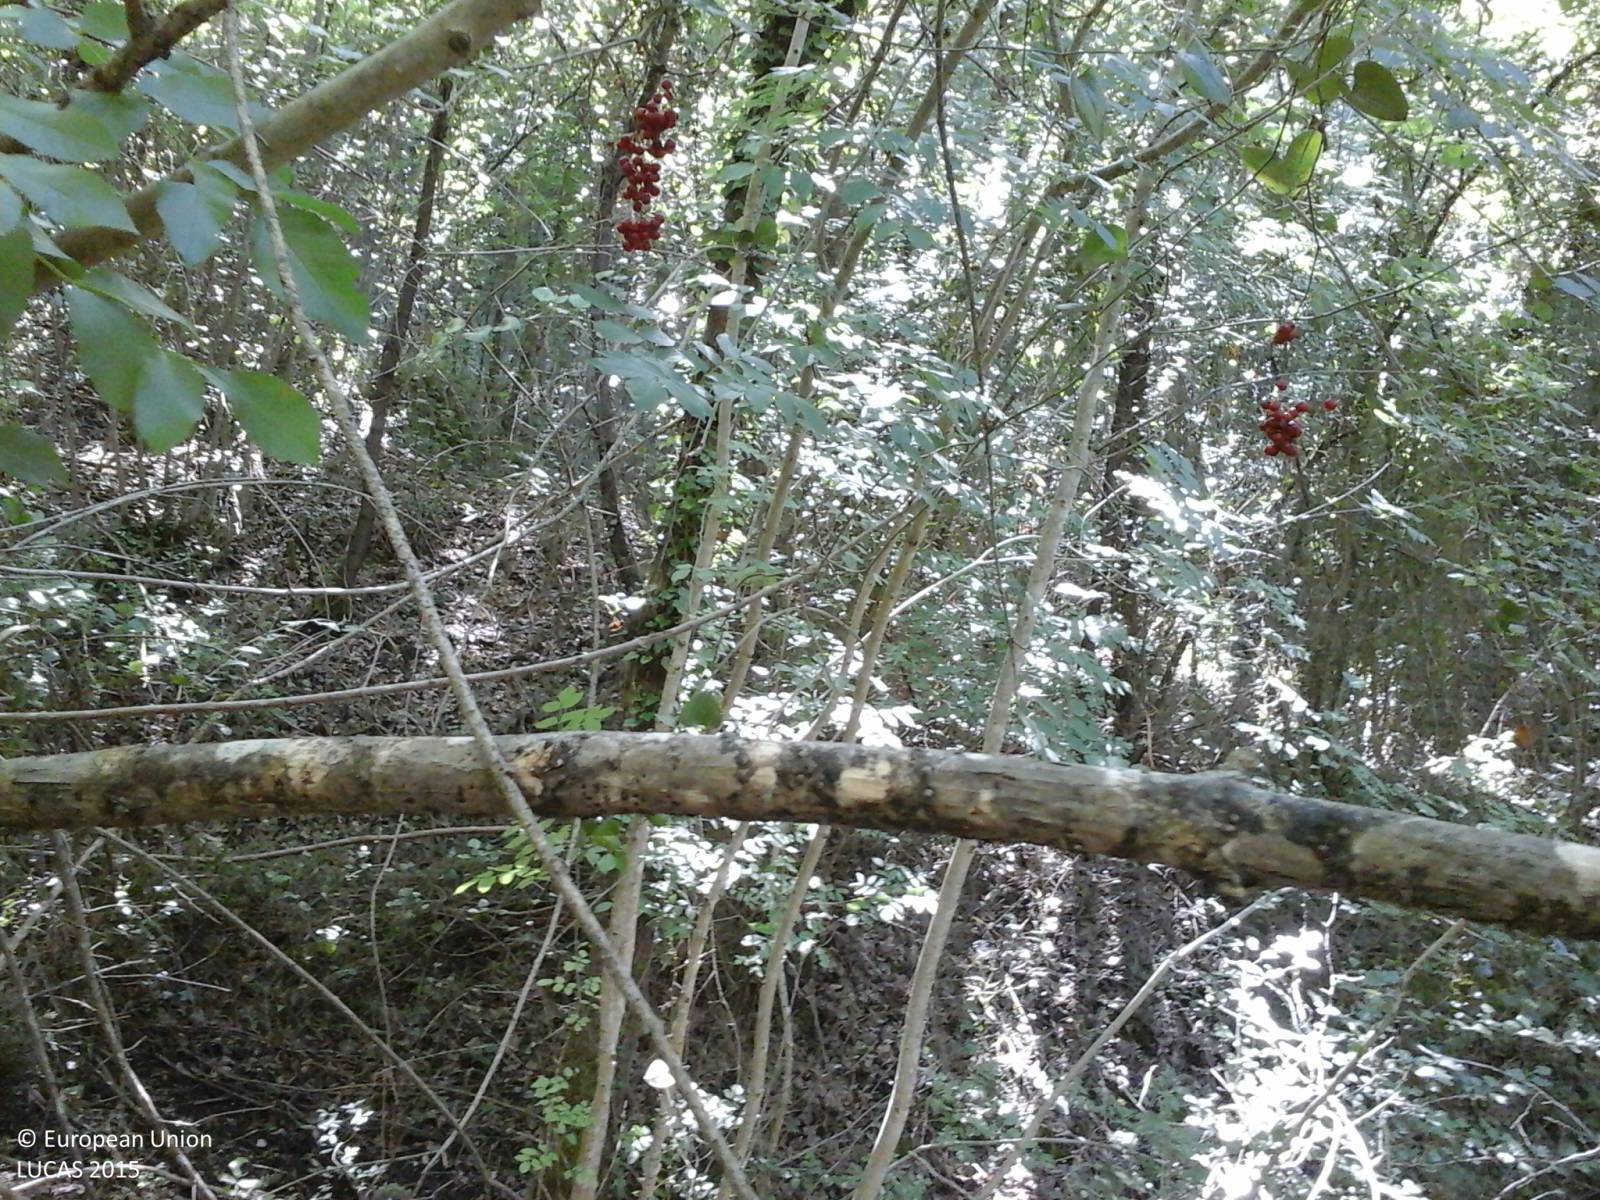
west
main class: Woodland
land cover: Broadleaved woodland
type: thermophilous deciduous forest
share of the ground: > 75 %
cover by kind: broadleaved forest trees 90 %, shrubs 10 %
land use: Forestry
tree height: > 5 m
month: June
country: IT
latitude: 42.4836
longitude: 12.2916
